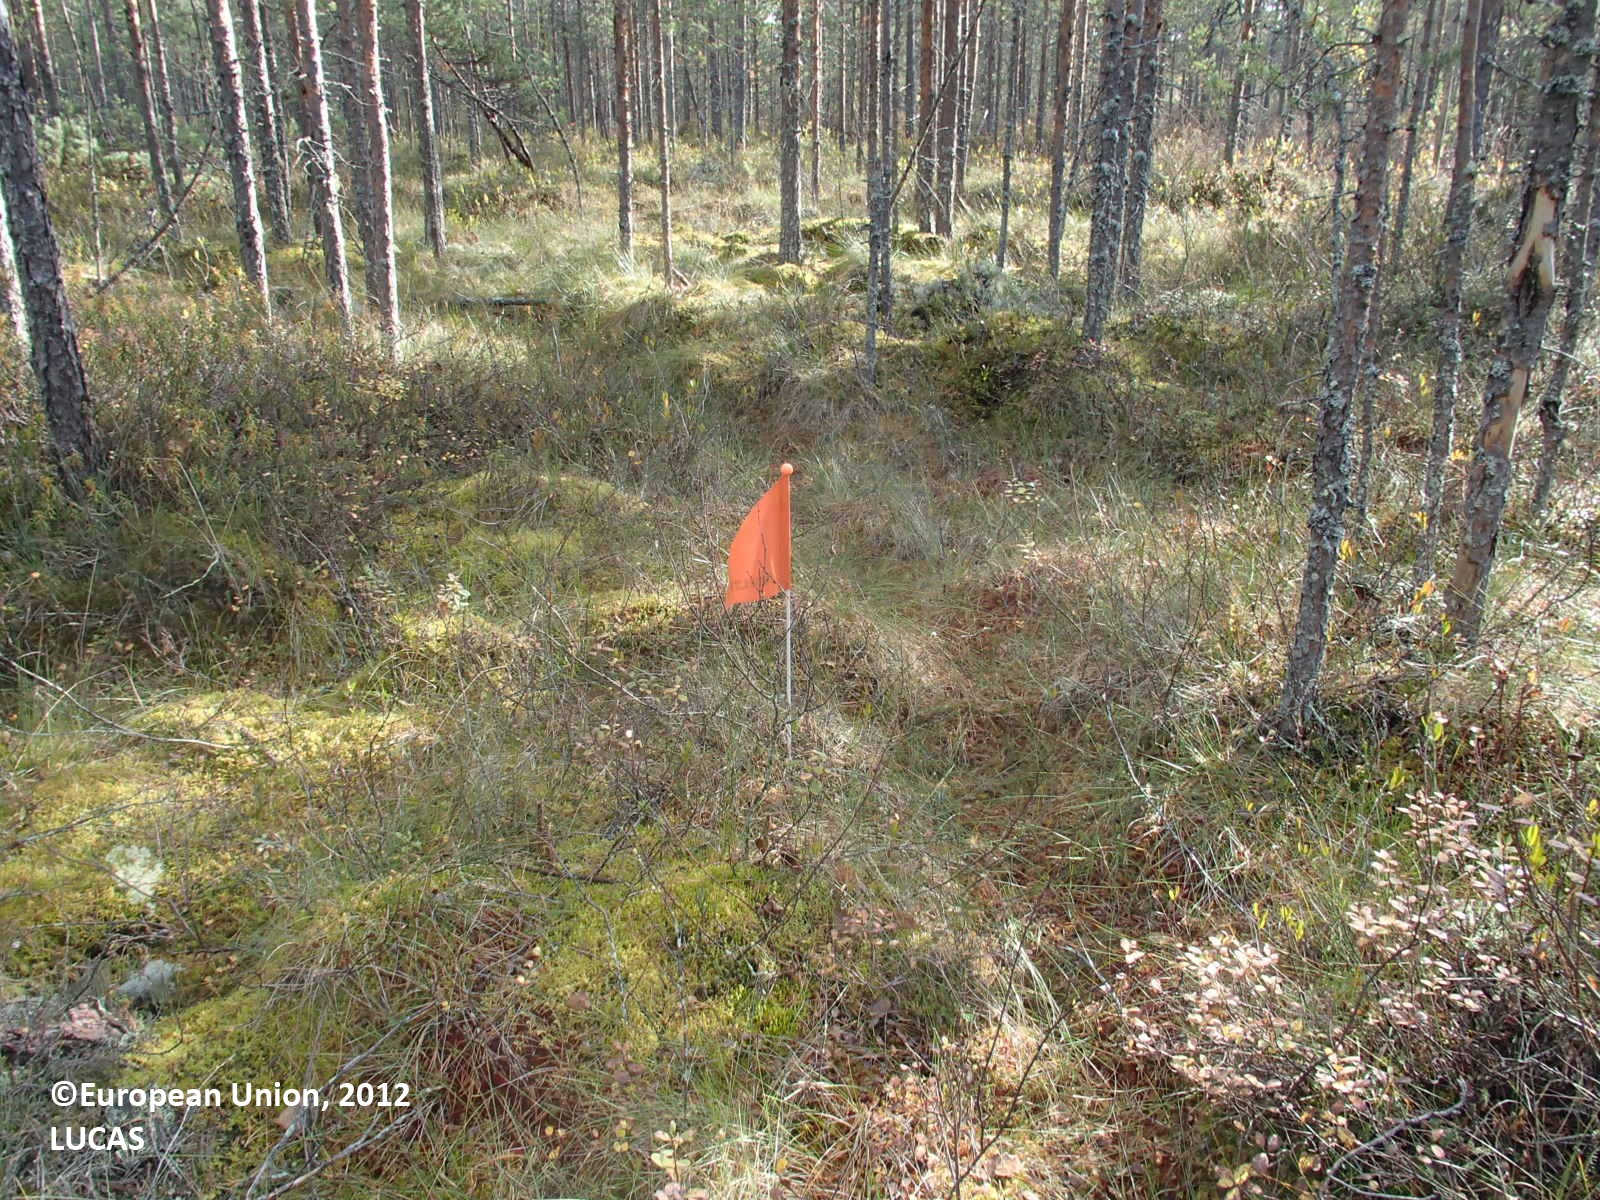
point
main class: Woodland
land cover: Pine dominated coniferous woodland
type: boreal forest
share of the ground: 50 - 75 %
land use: Forestry
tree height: > 5 m
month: September
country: FI
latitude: 63.6220
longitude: 26.1129
